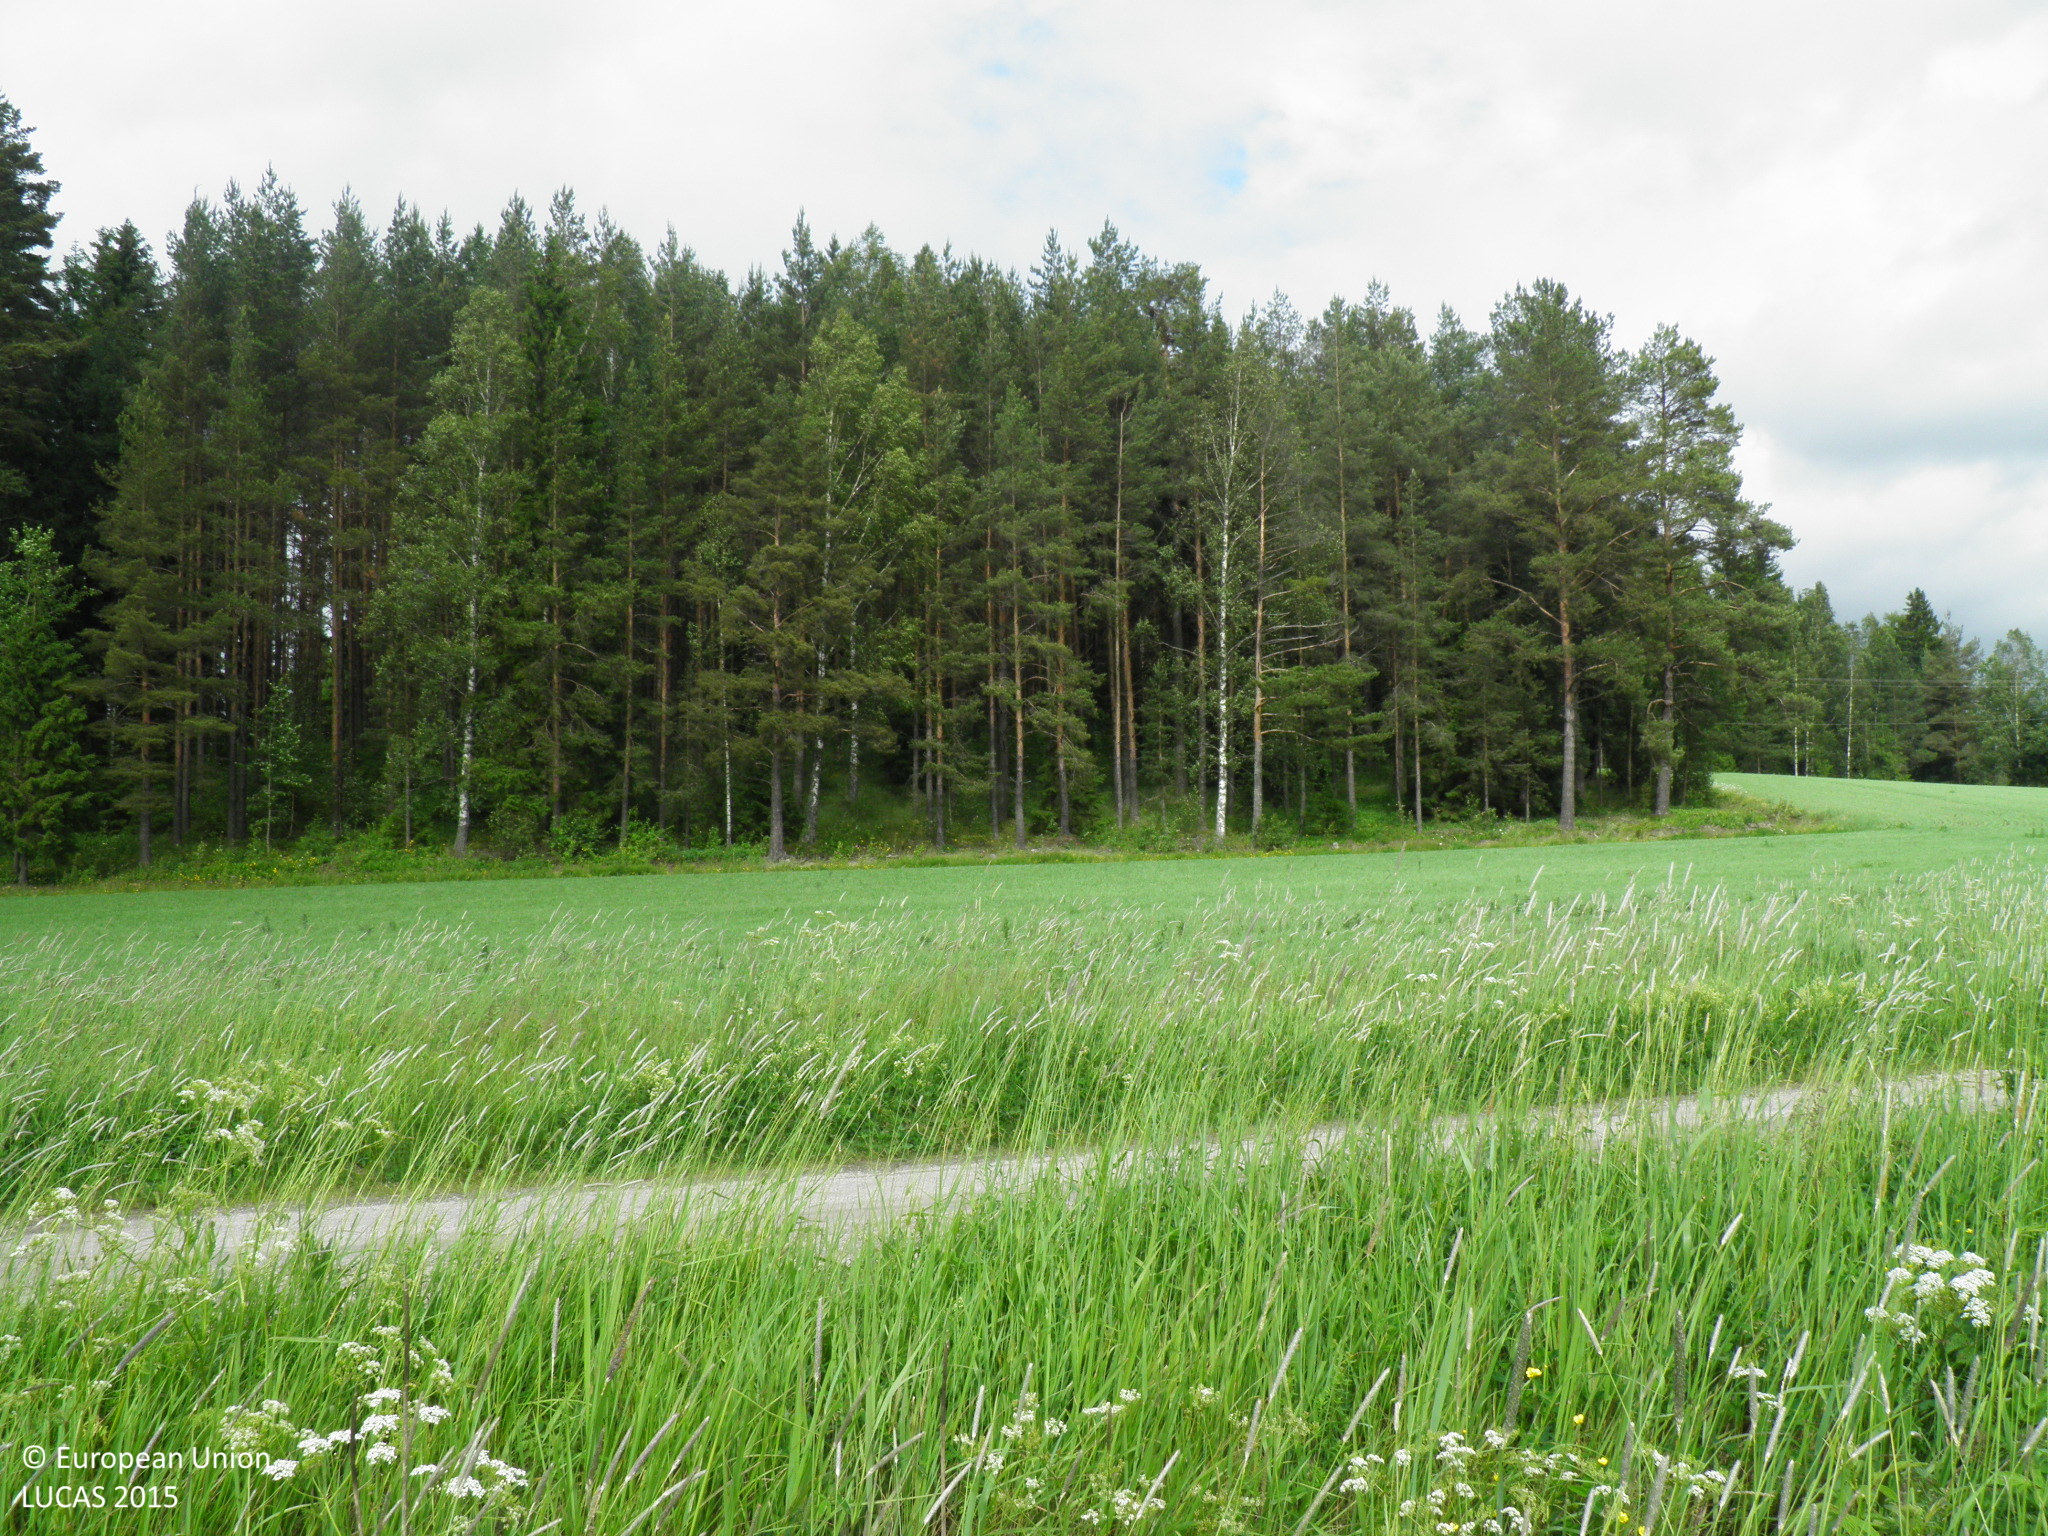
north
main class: Cropland
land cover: Rape and turnip rape
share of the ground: > 75 %
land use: Agriculture (excluding fallow land and kitchen gardens)
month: June
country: FI
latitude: 60.4099
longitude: 22.8760
